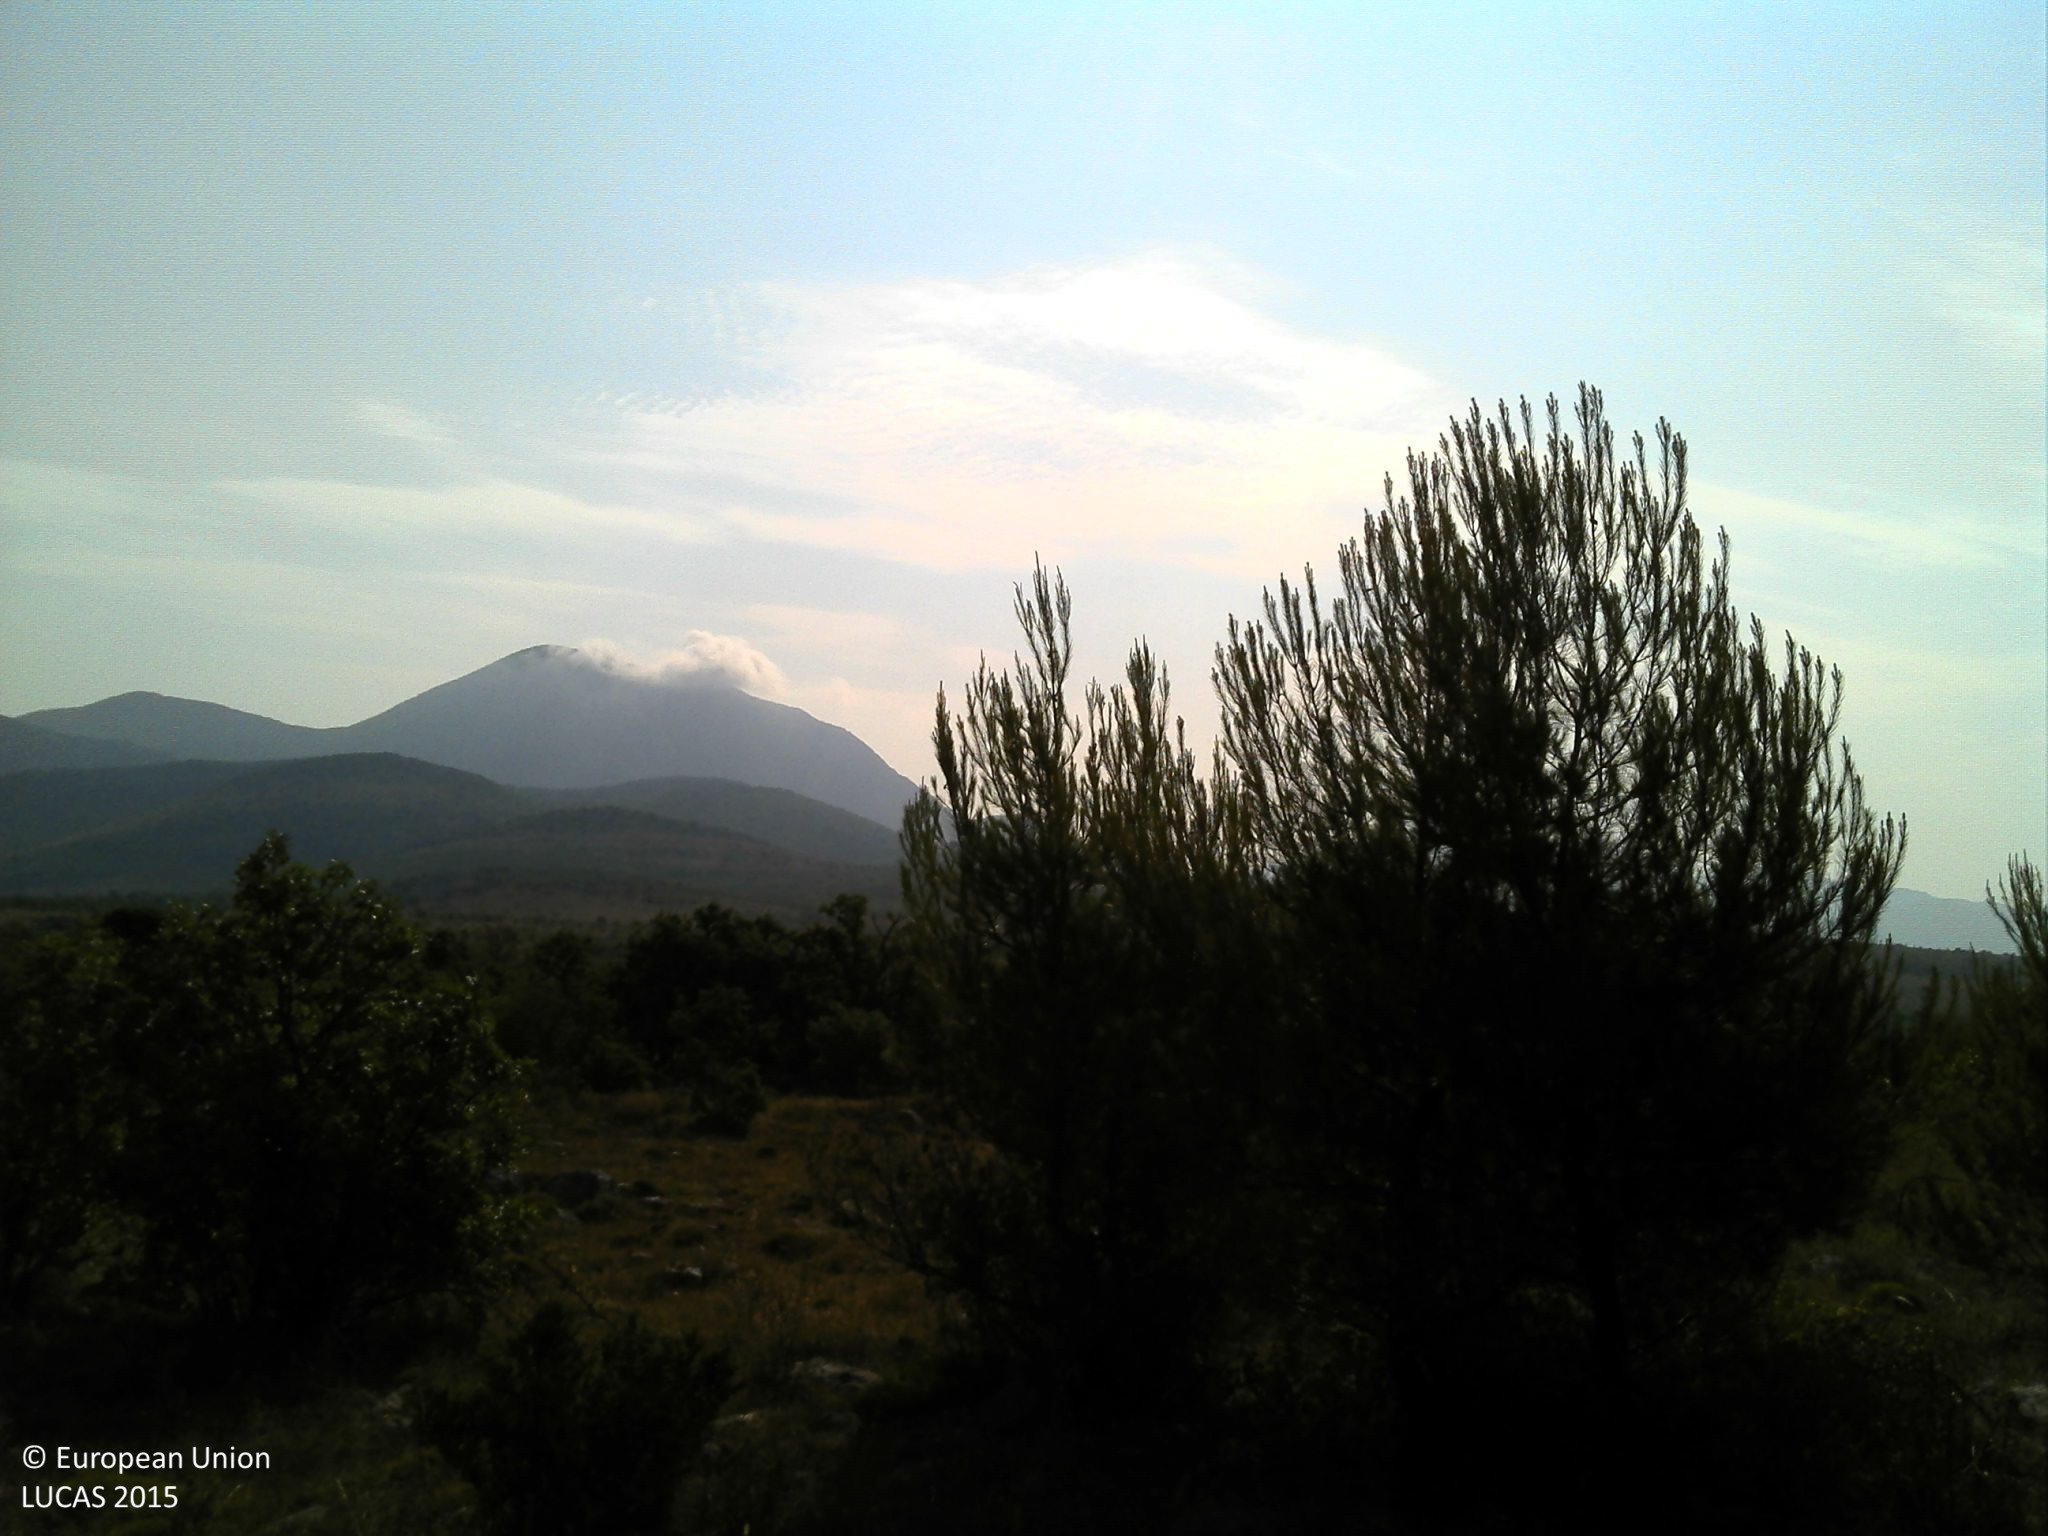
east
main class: Woodland
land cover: Pine dominated coniferous woodland
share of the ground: 10 - 25 %
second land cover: Grassland without tree/shrub cover
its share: > 75 %
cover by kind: consolidated bare surface 35 %, herbaceous plants 30 %, coniferous forest trees 25 %, shrubs 10 %
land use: Agriculture (excluding fallow land and kitchen gardens)
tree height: > 5 m
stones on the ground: 25 - 50 %
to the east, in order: Pine dominated coniferous woodland; Grassland without tree/shrub cover; Grassland with sparse tree/shrub cover
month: July
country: HR
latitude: 42.8239
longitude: 17.8065
